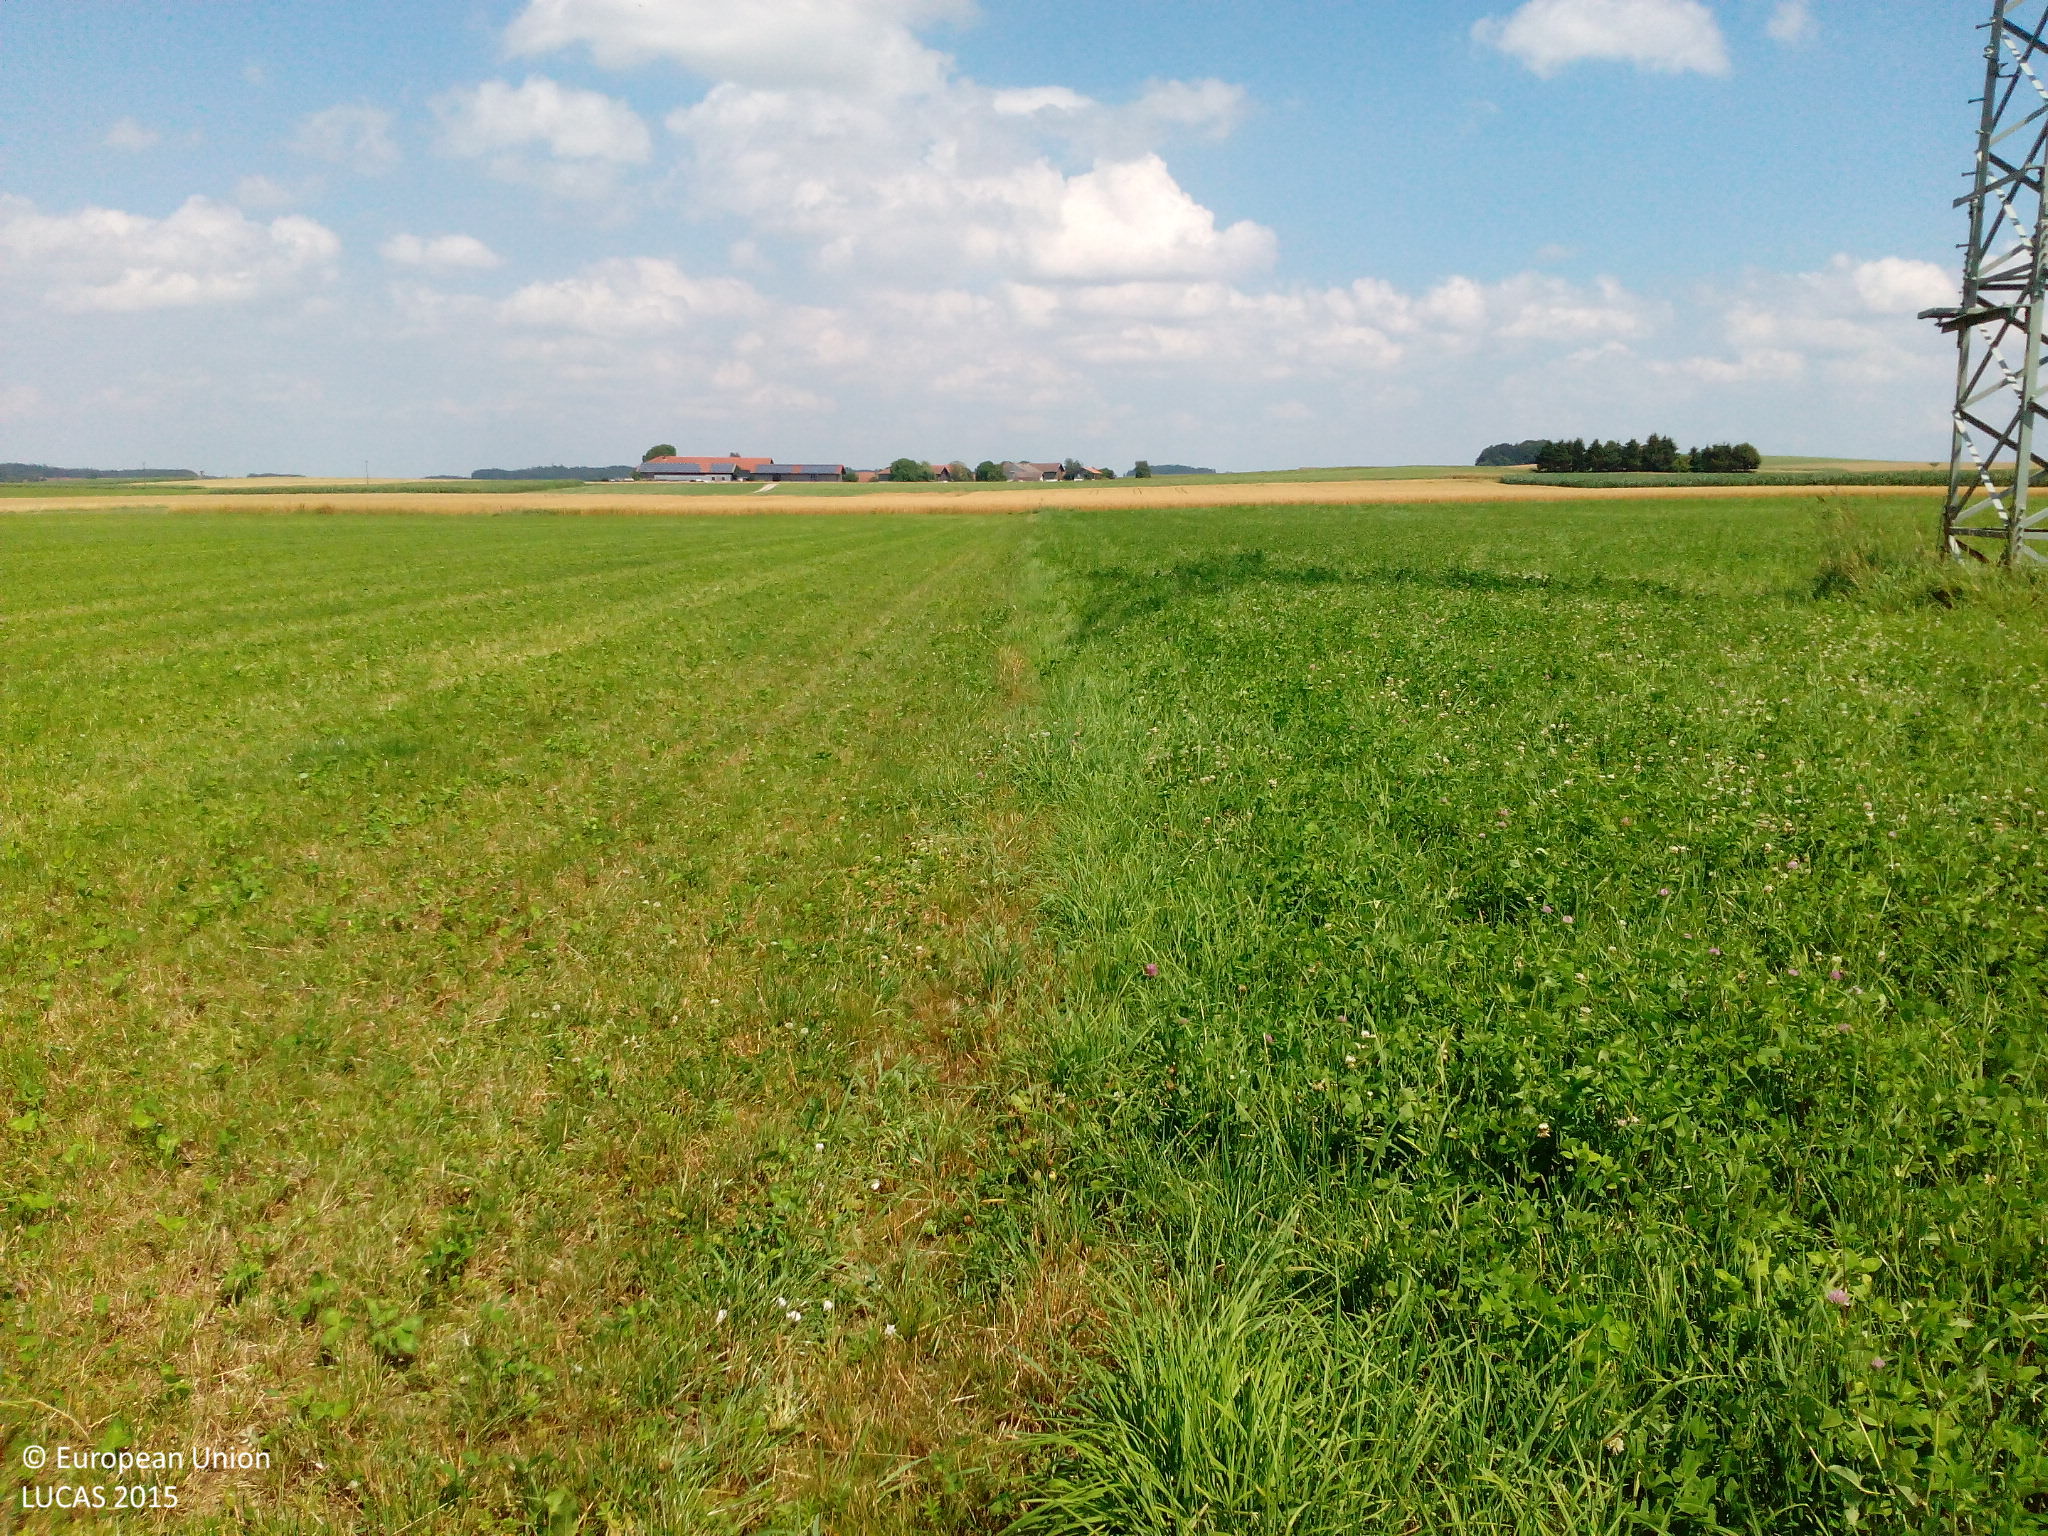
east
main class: Cropland
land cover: Clovers
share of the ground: > 75 %
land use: Agriculture (excluding fallow land and kitchen gardens)
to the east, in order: Clovers; Electric lines; Clovers; Grass margins; Common wheat
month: July
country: DE
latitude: 48.0360
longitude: 12.3727
